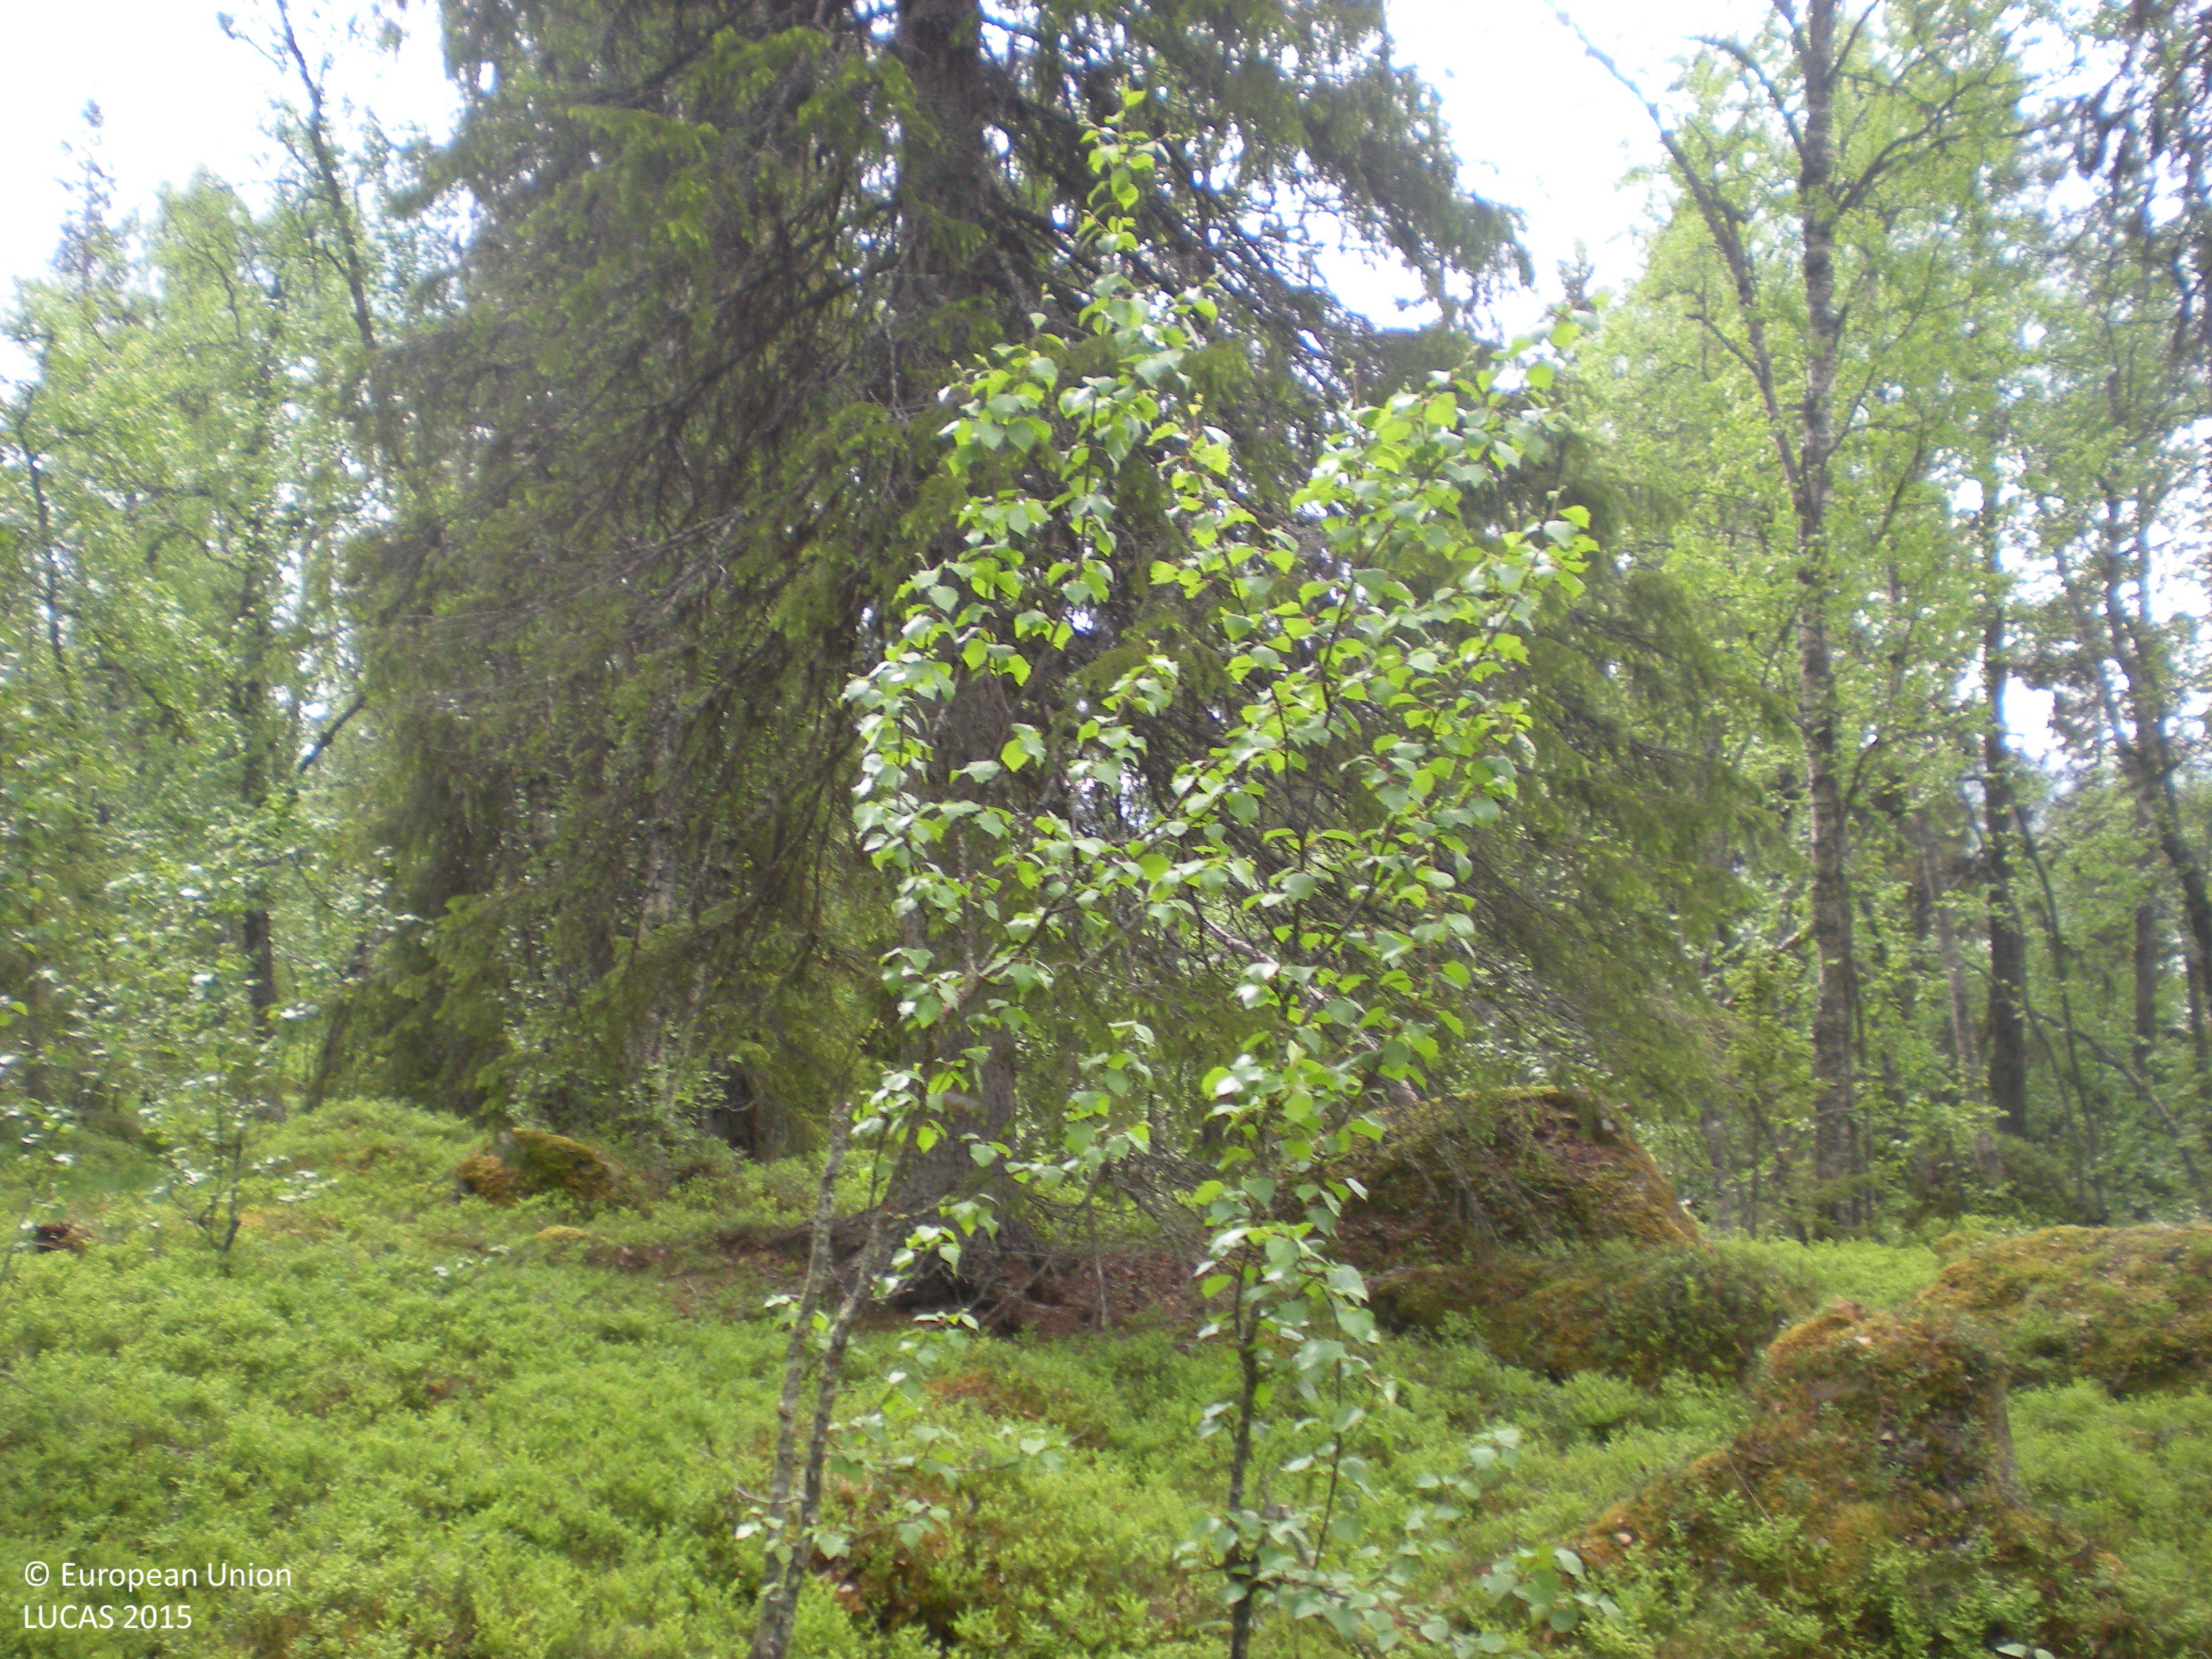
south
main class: Woodland
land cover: Other mixed woodland
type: boreal forest
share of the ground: 50 - 75 %
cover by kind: coniferous forest trees 50 %, broadleaved forest trees 20 %, shrubs 20 %, lichens and mosses 10 %
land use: Forestry
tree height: > 5 m
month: July
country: SE
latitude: 66.1611
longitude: 17.1615
